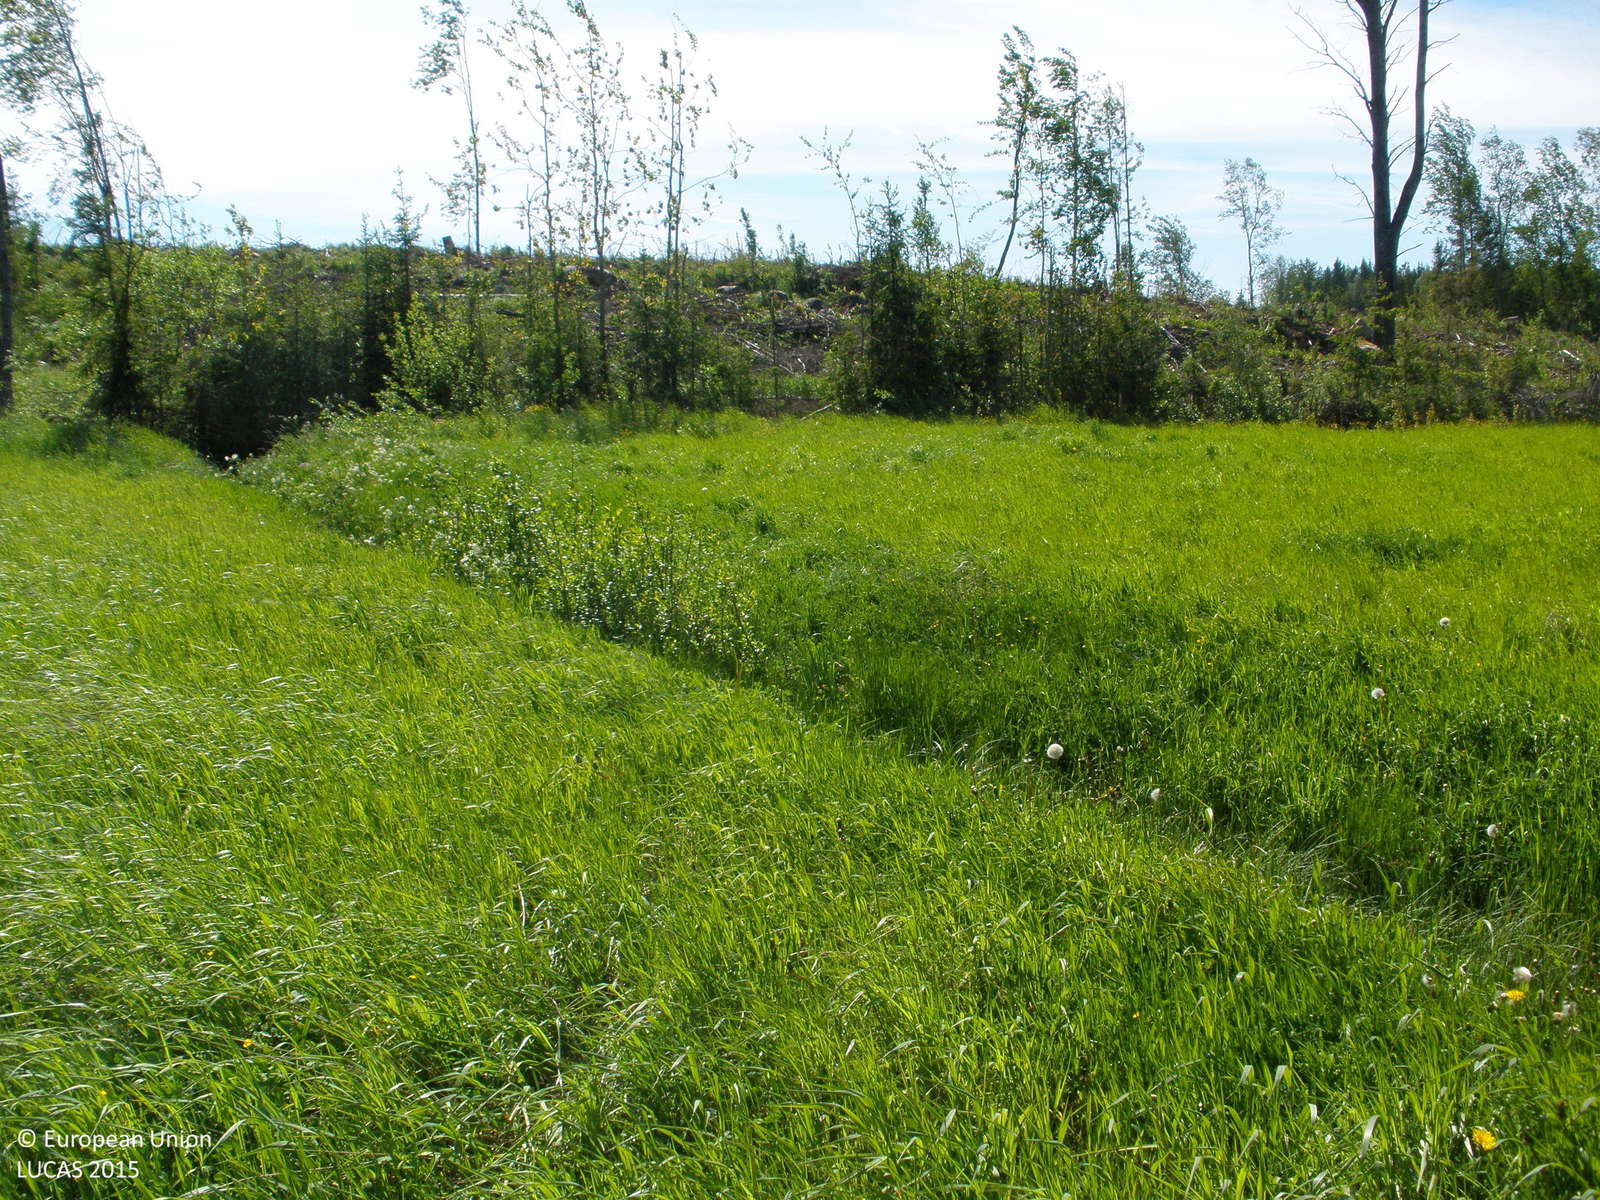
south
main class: Cropland
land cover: Temporary grasslands
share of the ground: > 75 %
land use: Agriculture (excluding fallow land and kitchen gardens)
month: June
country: FI
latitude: 60.7300
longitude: 23.5628
